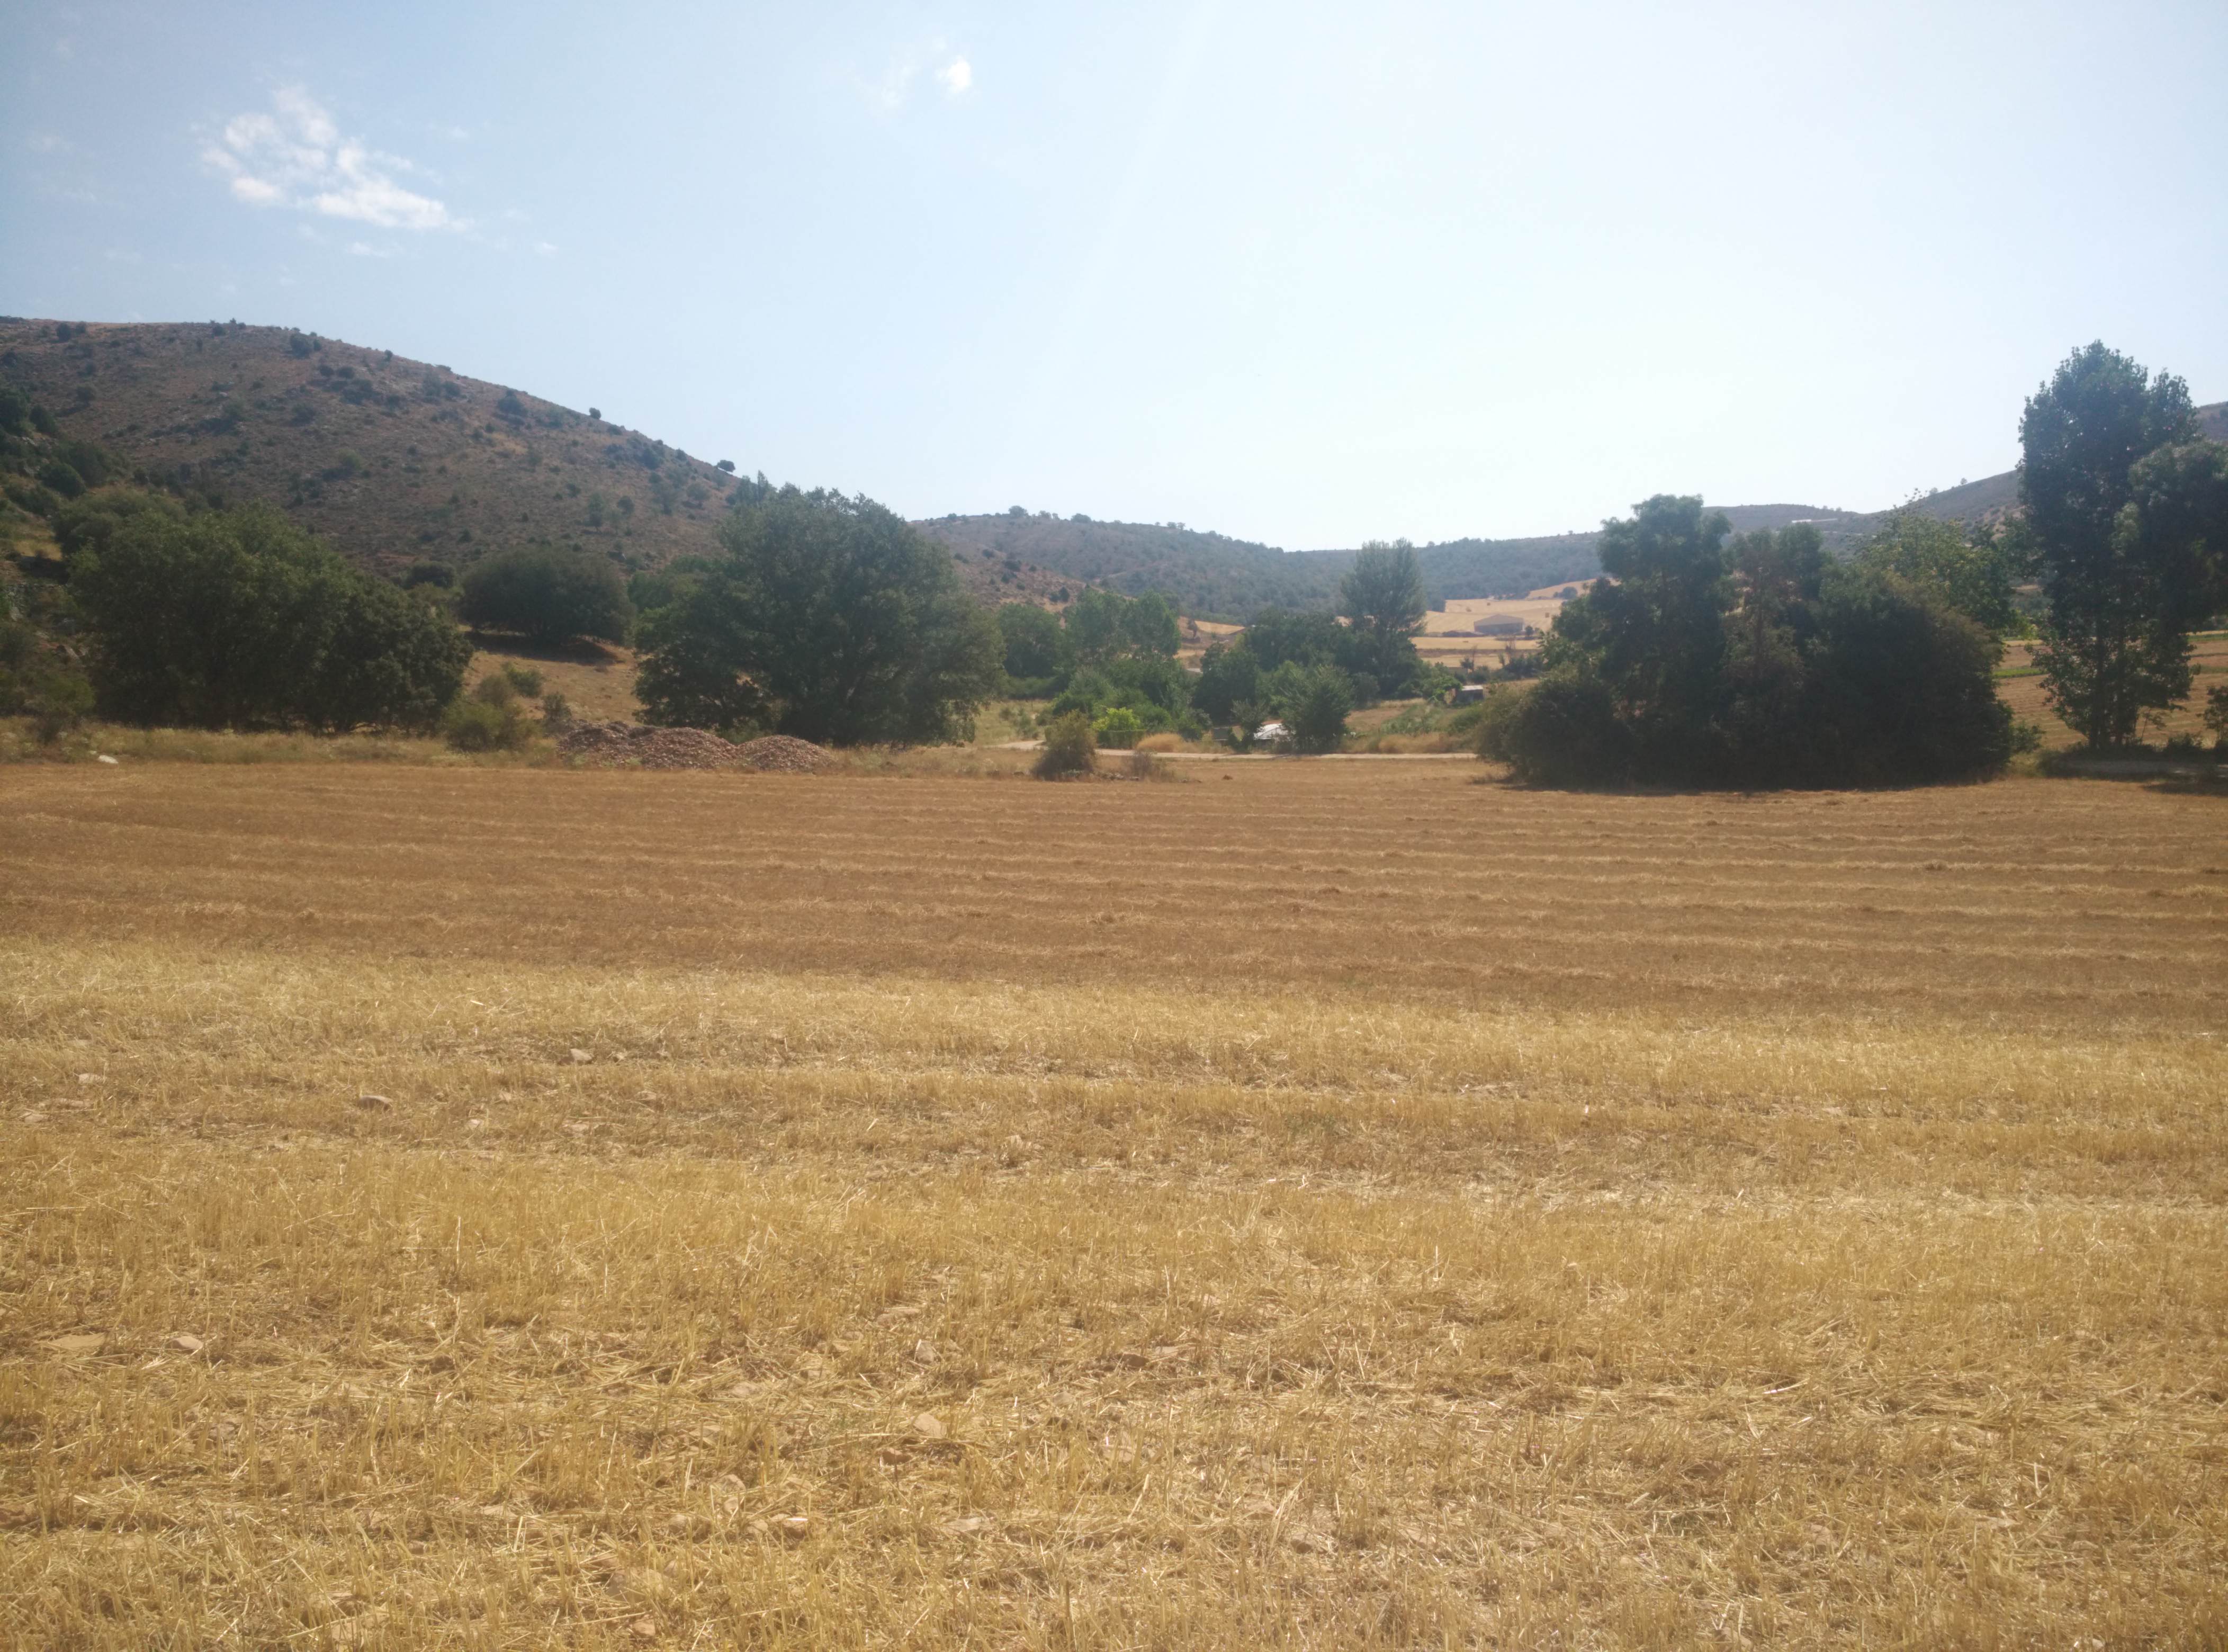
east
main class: Cropland
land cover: Common wheat
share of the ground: < 10 %
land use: Agriculture (excluding fallow land and kitchen gardens)
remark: Harvested field
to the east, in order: Common wheat; Barley; Single bushes/trees; Barley; Tracks; Fences; Apple fruit; Fences; Grass margins; Rivers and streams; Grass margins; Arable land (only in case pi)
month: July
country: ES
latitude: 41.0174
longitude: -2.6489
